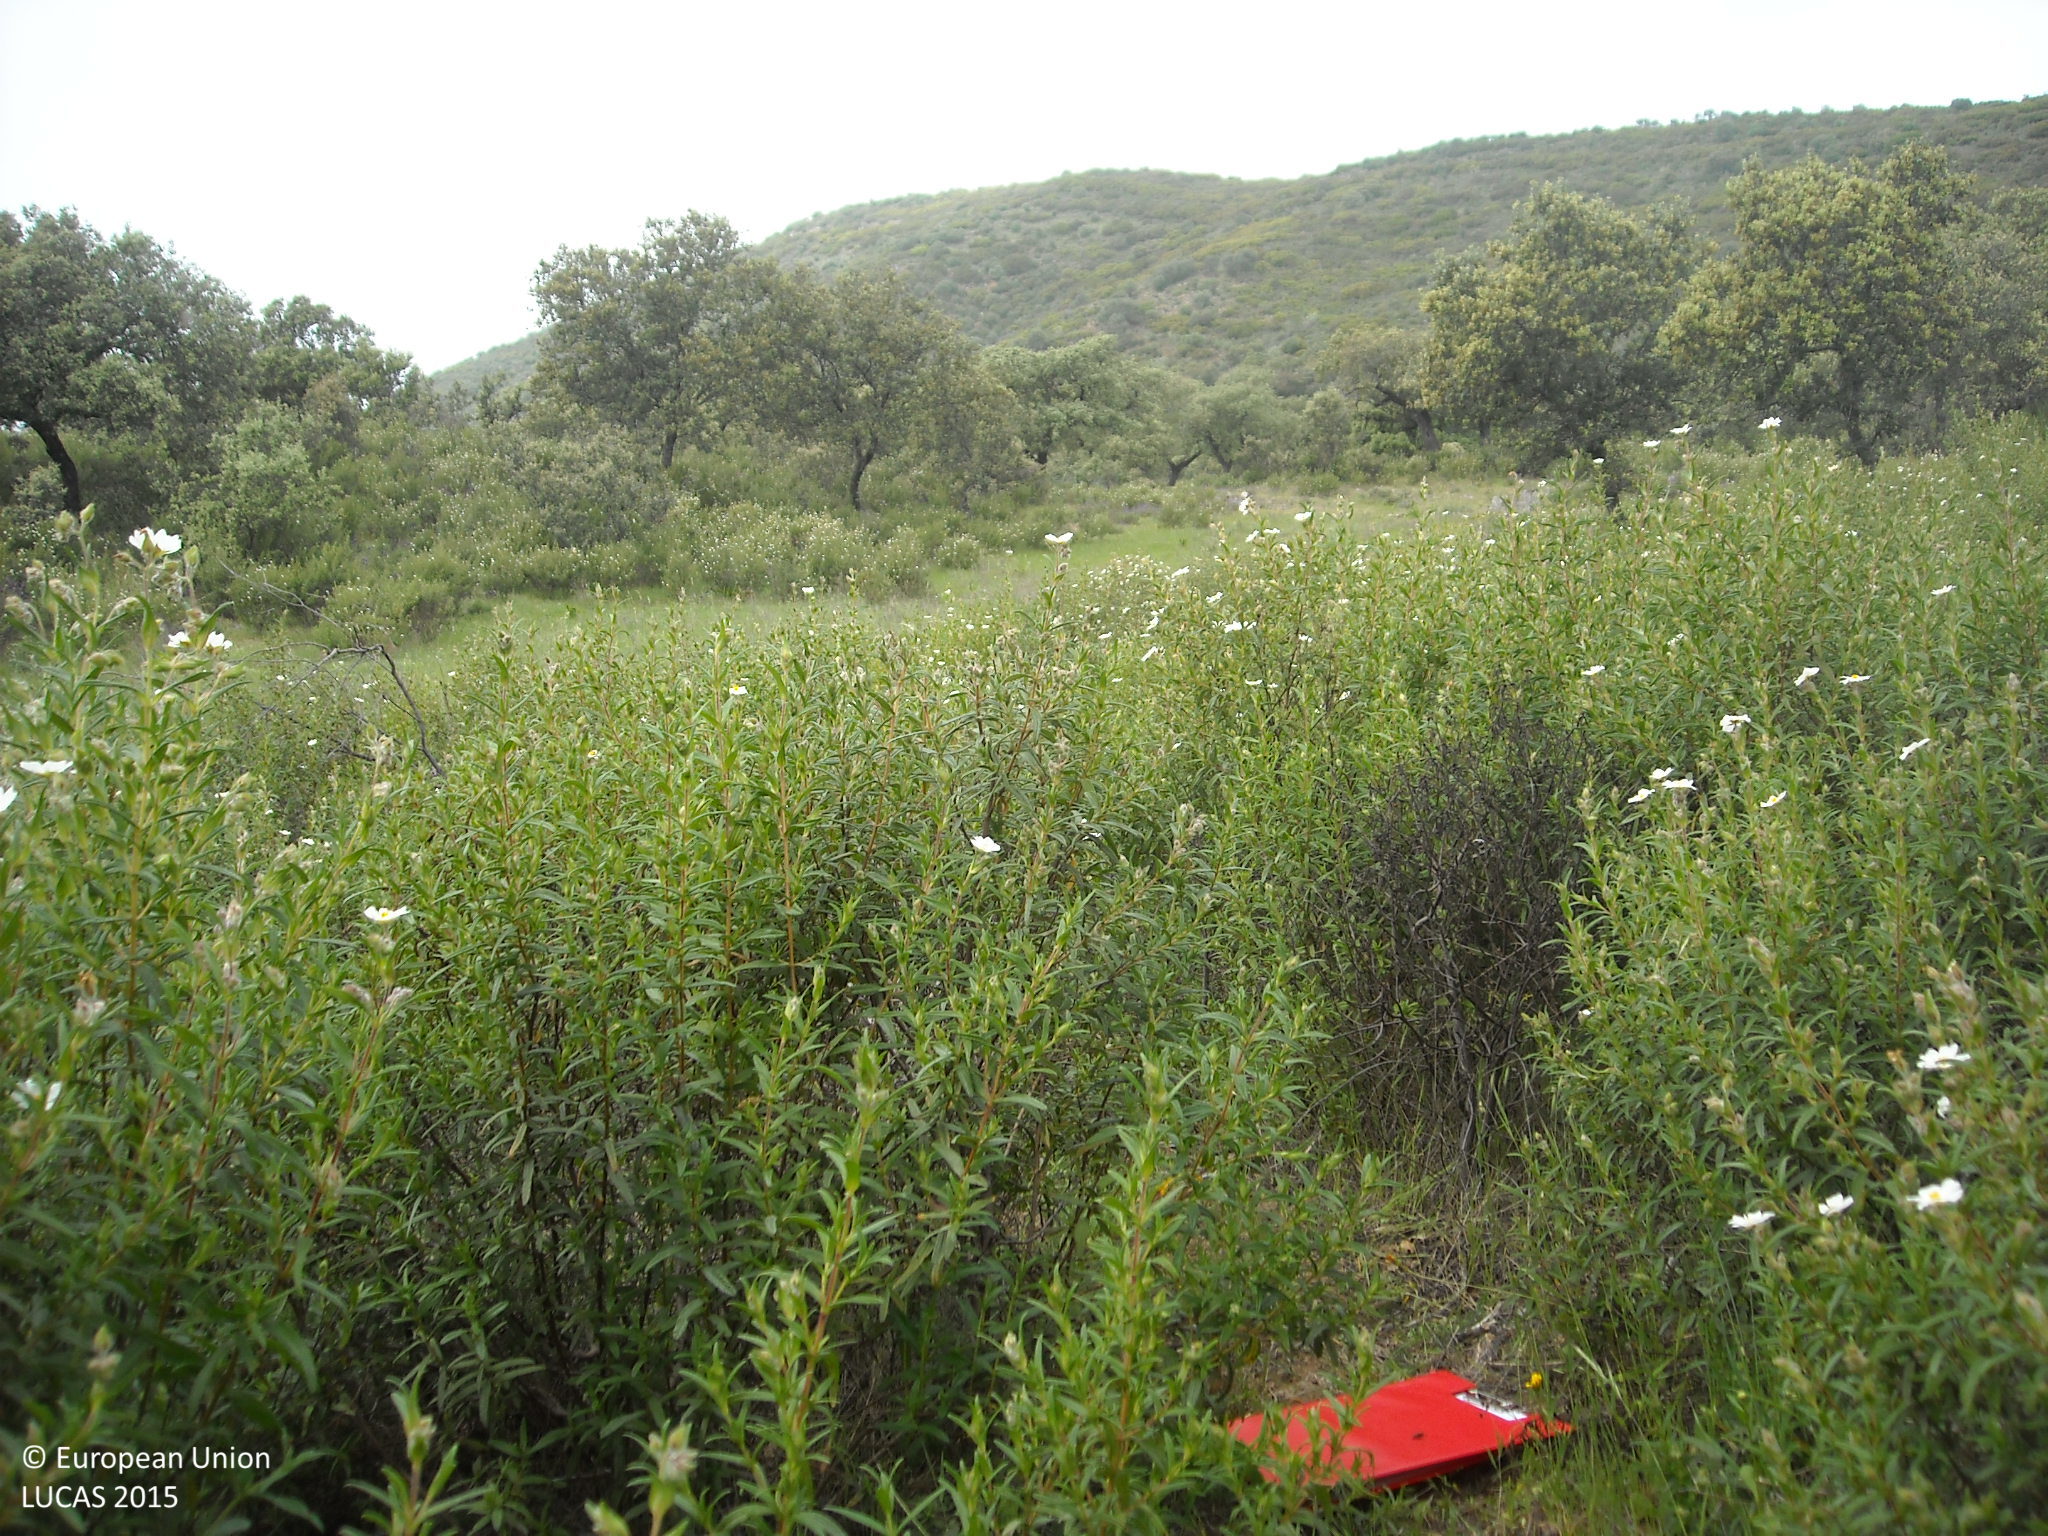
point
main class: Woodland
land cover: Broadleaved woodland
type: broadleaved evergreen forest
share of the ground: 10 - 25 %
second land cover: Shrubland without tree cover
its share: > 75 %
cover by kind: shrubs 75 %, broadleaved forest trees 20 %, herbaceous plants 5 %
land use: Forestry
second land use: Agriculture (excluding fallow land and kitchen gardens)
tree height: > 5 m
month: April
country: ES
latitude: 37.9182
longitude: -6.2942
